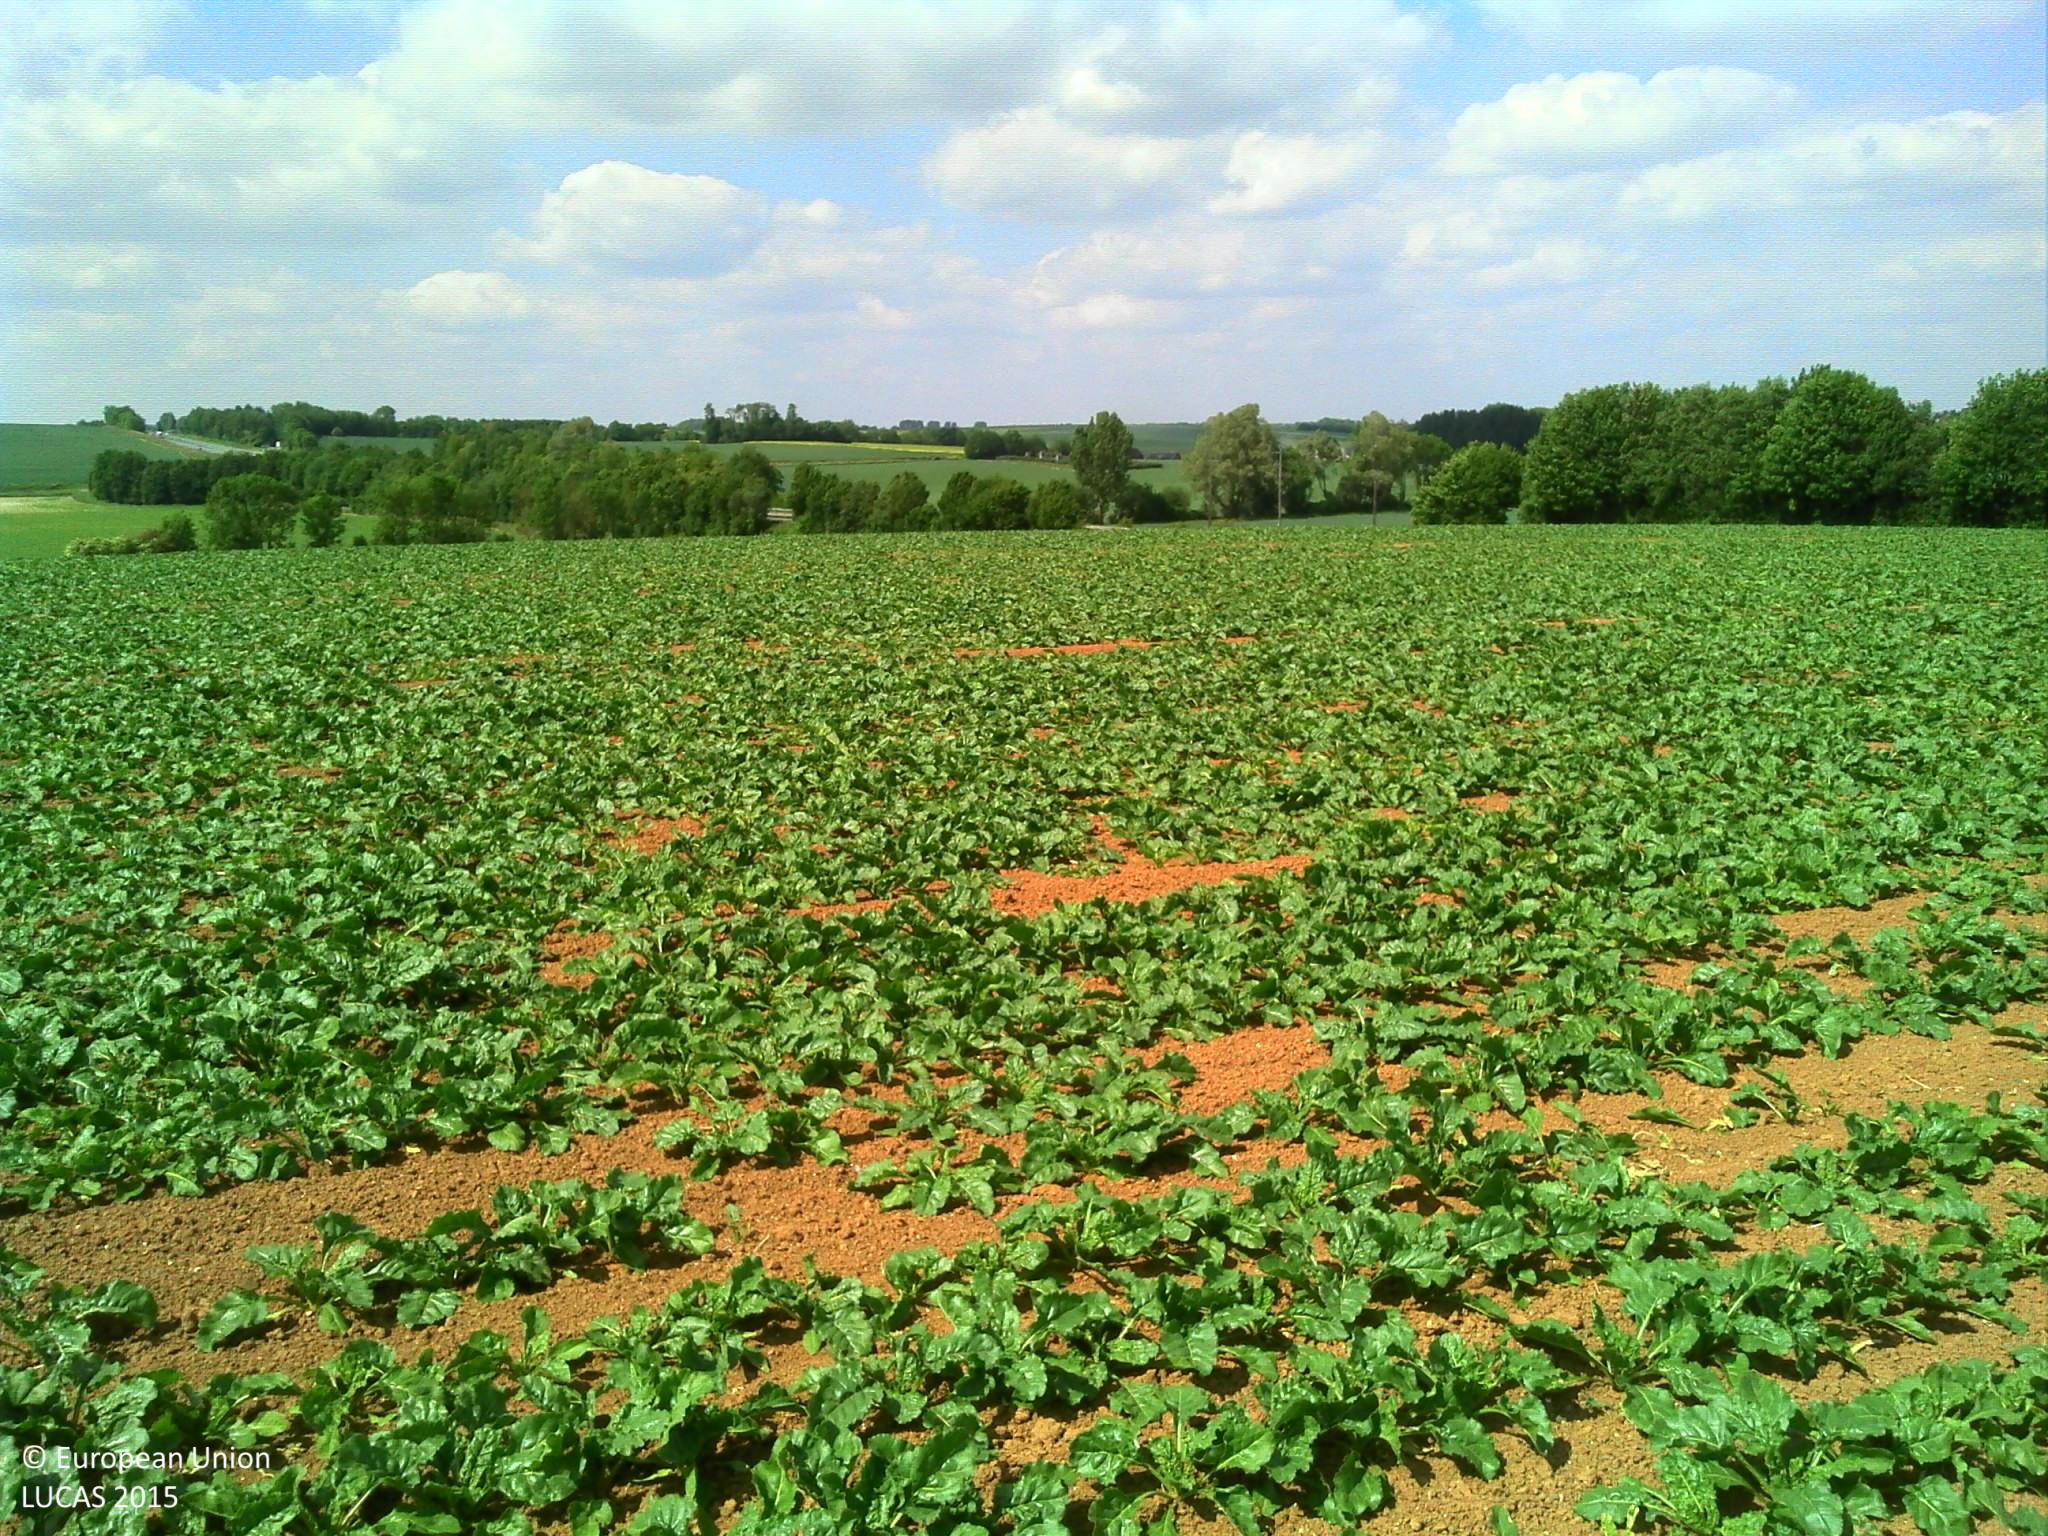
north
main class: Cropland
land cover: Sugar beet
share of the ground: > 75 %
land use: Agriculture (excluding fallow land and kitchen gardens)
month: May
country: FR
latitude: 49.9112
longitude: 3.2376
